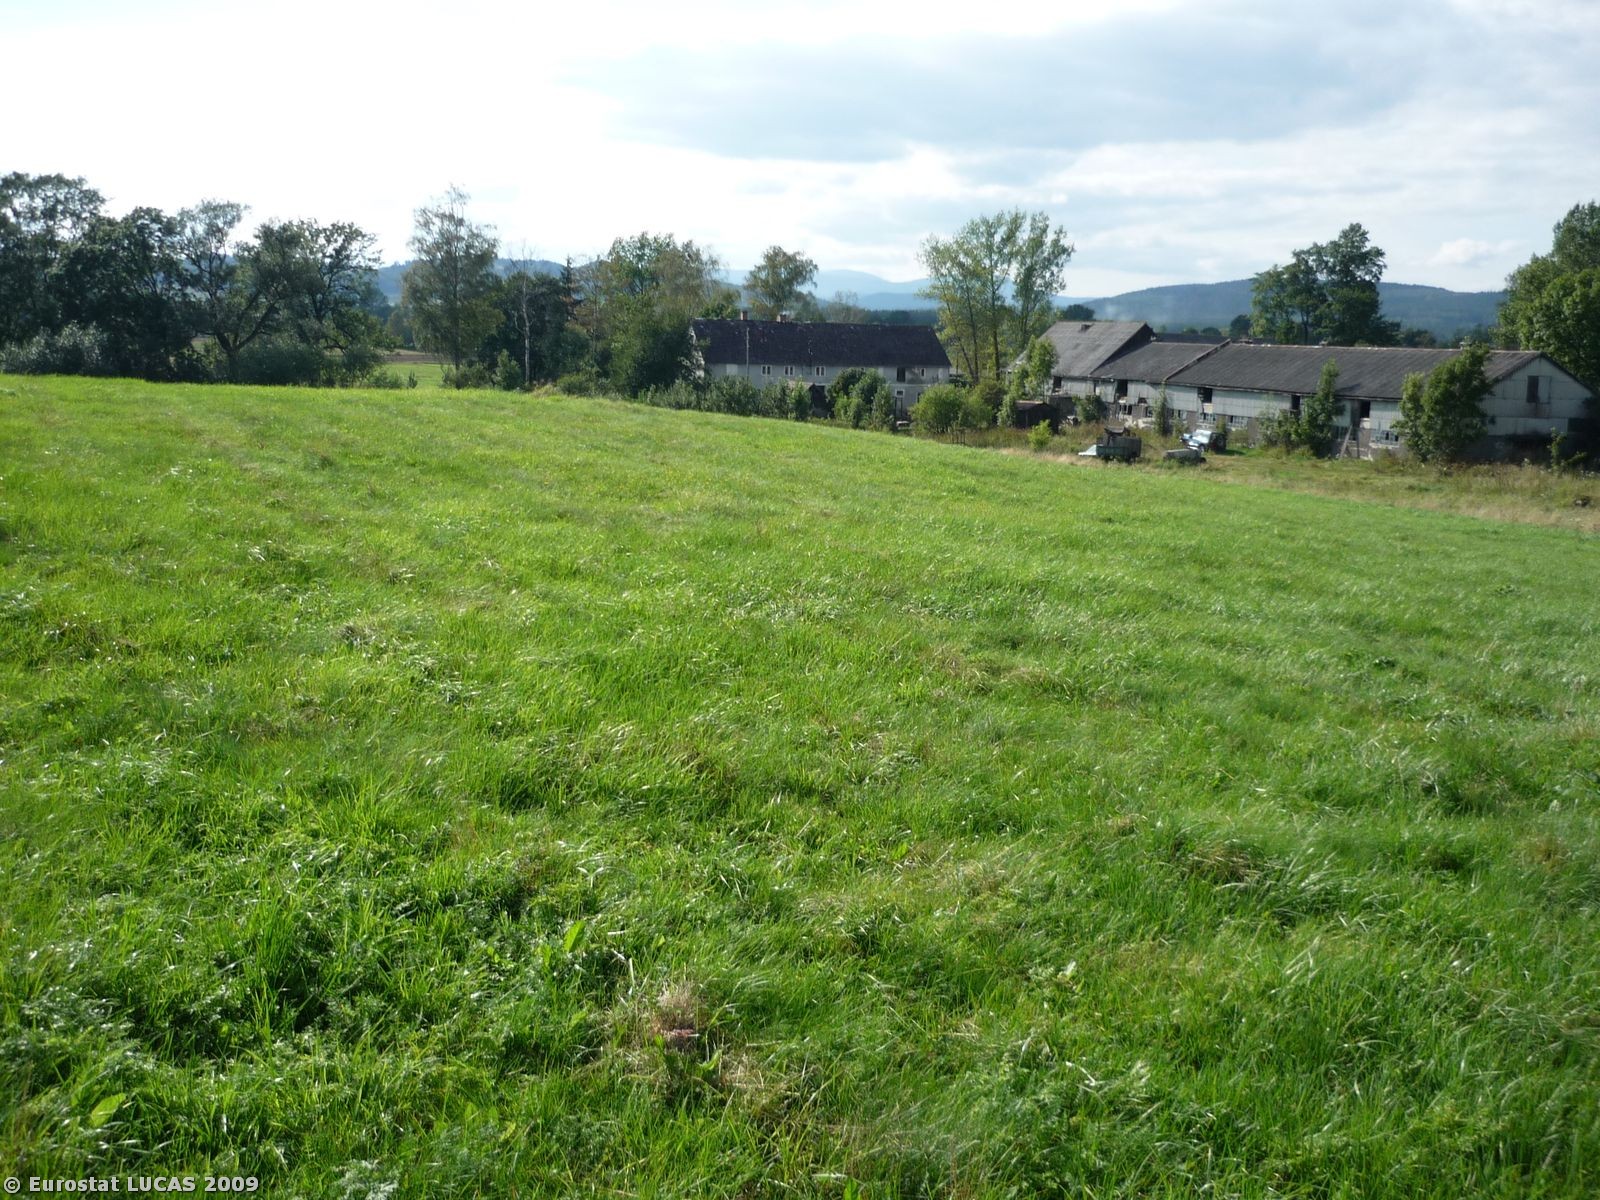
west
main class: Grassland
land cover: Grassland without tree/shrub cover
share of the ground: > 75 %
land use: Agriculture (excluding fallow land and kitchen gardens)
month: September
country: PL
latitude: 50.7251
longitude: 16.0833
